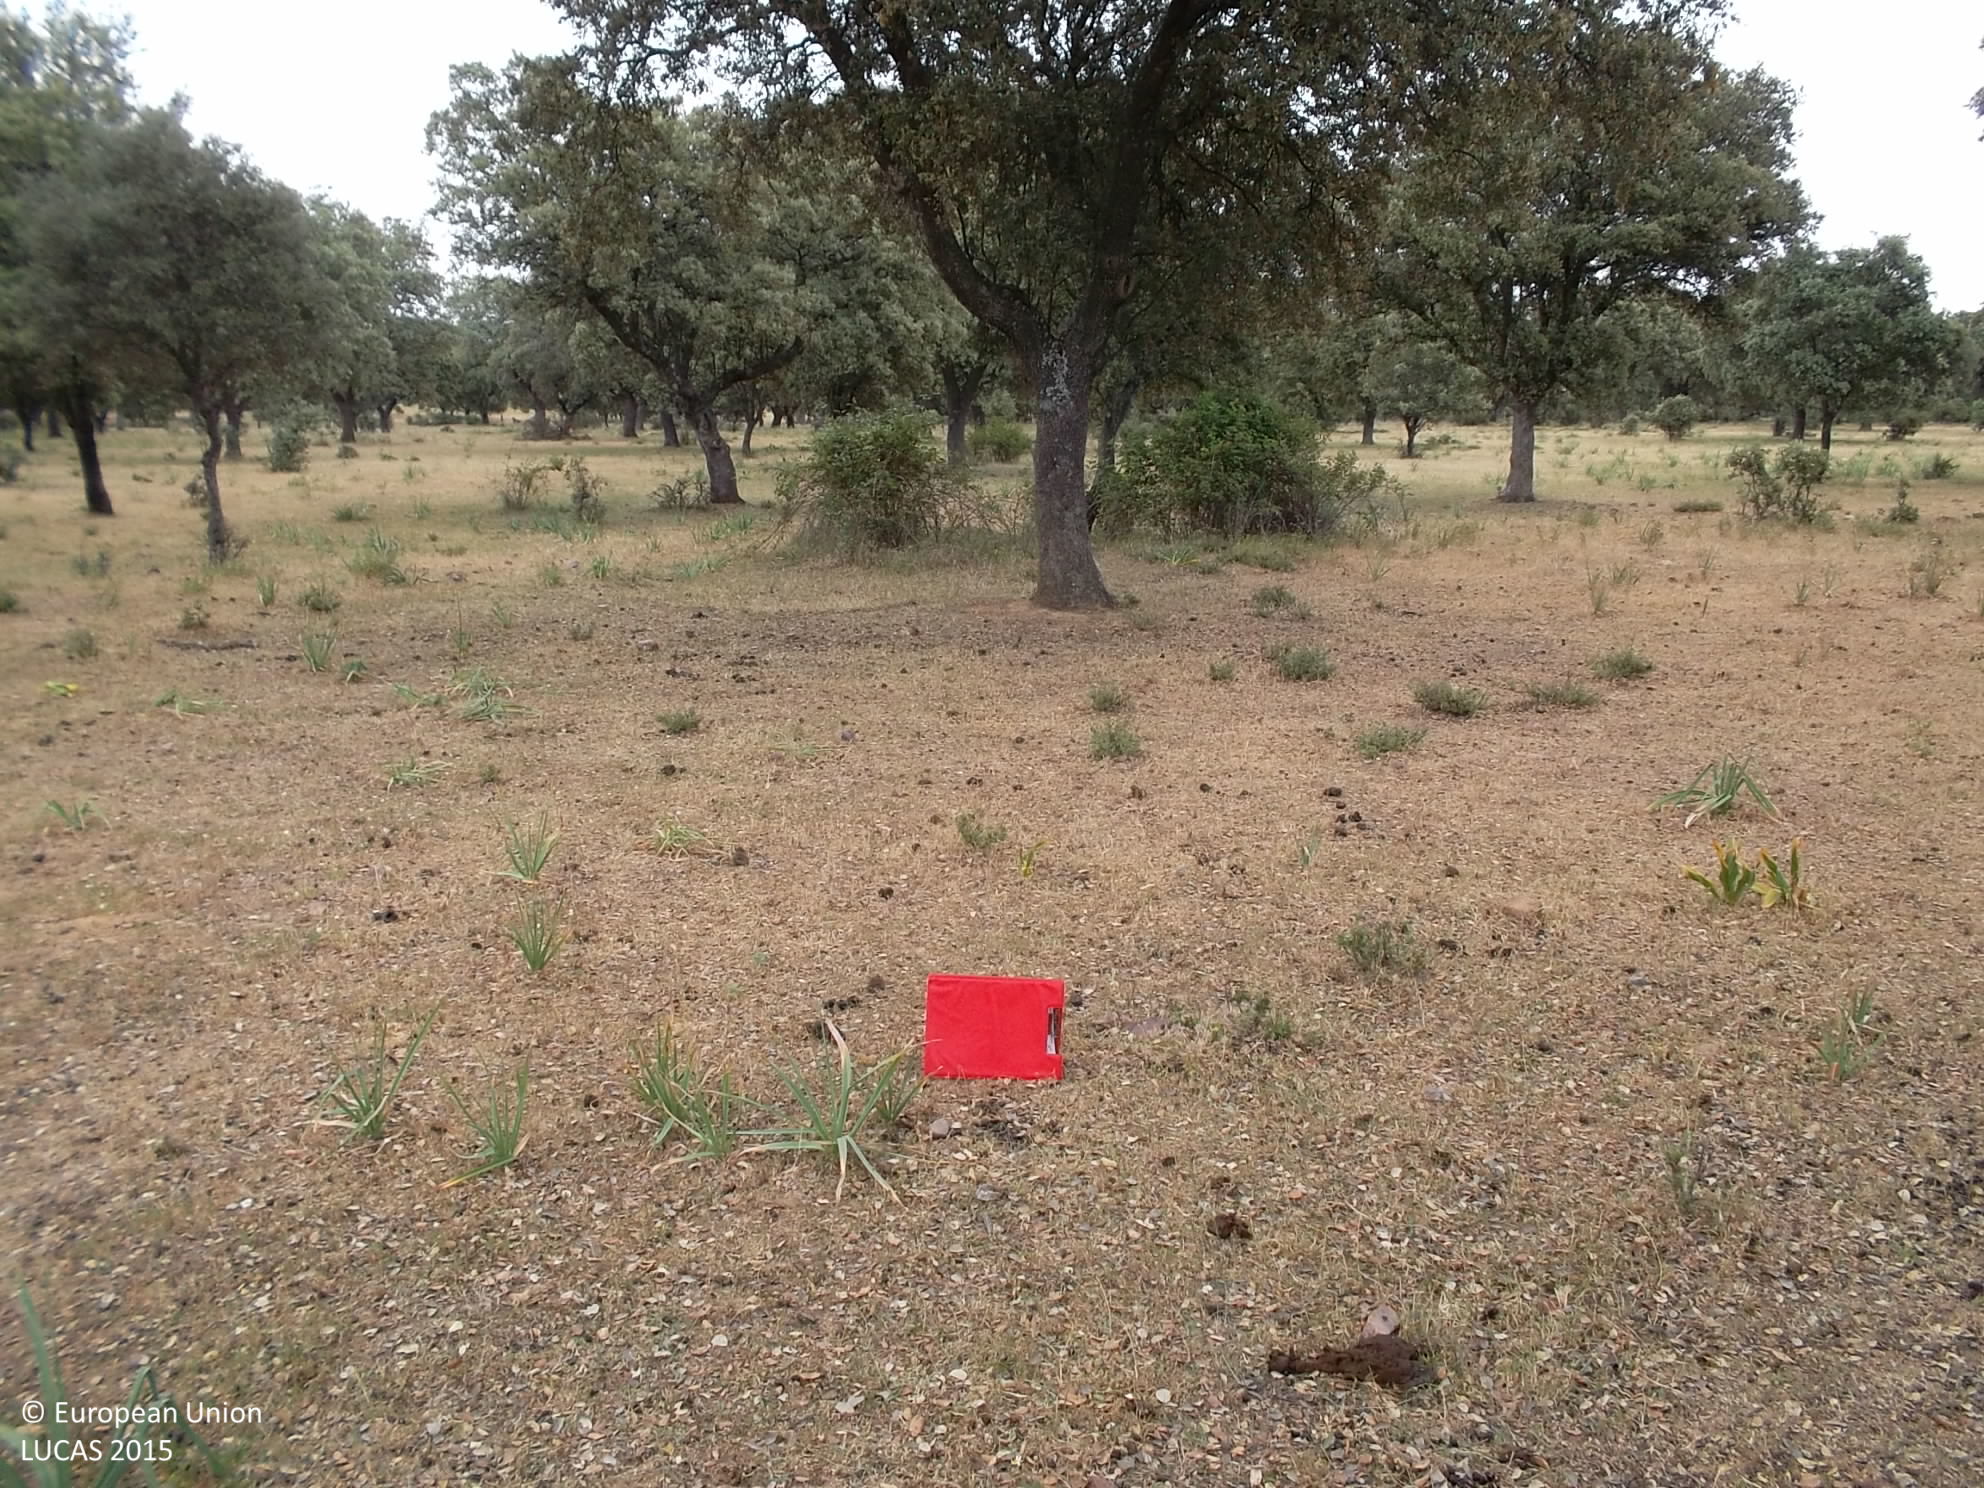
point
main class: Woodland
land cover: Broadleaved woodland
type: broadleaved evergreen forest
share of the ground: 25 - 50 %
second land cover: Spontaneously vegetated surfaces
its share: > 75 %
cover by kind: herbaceous plants 50 %, broadleaved forest trees 40 %, shrubs 10 %
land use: Forestry
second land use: Agriculture (excluding fallow land and kitchen gardens)
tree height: > 5 m
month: May
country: ES
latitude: 38.5710
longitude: -4.4251
